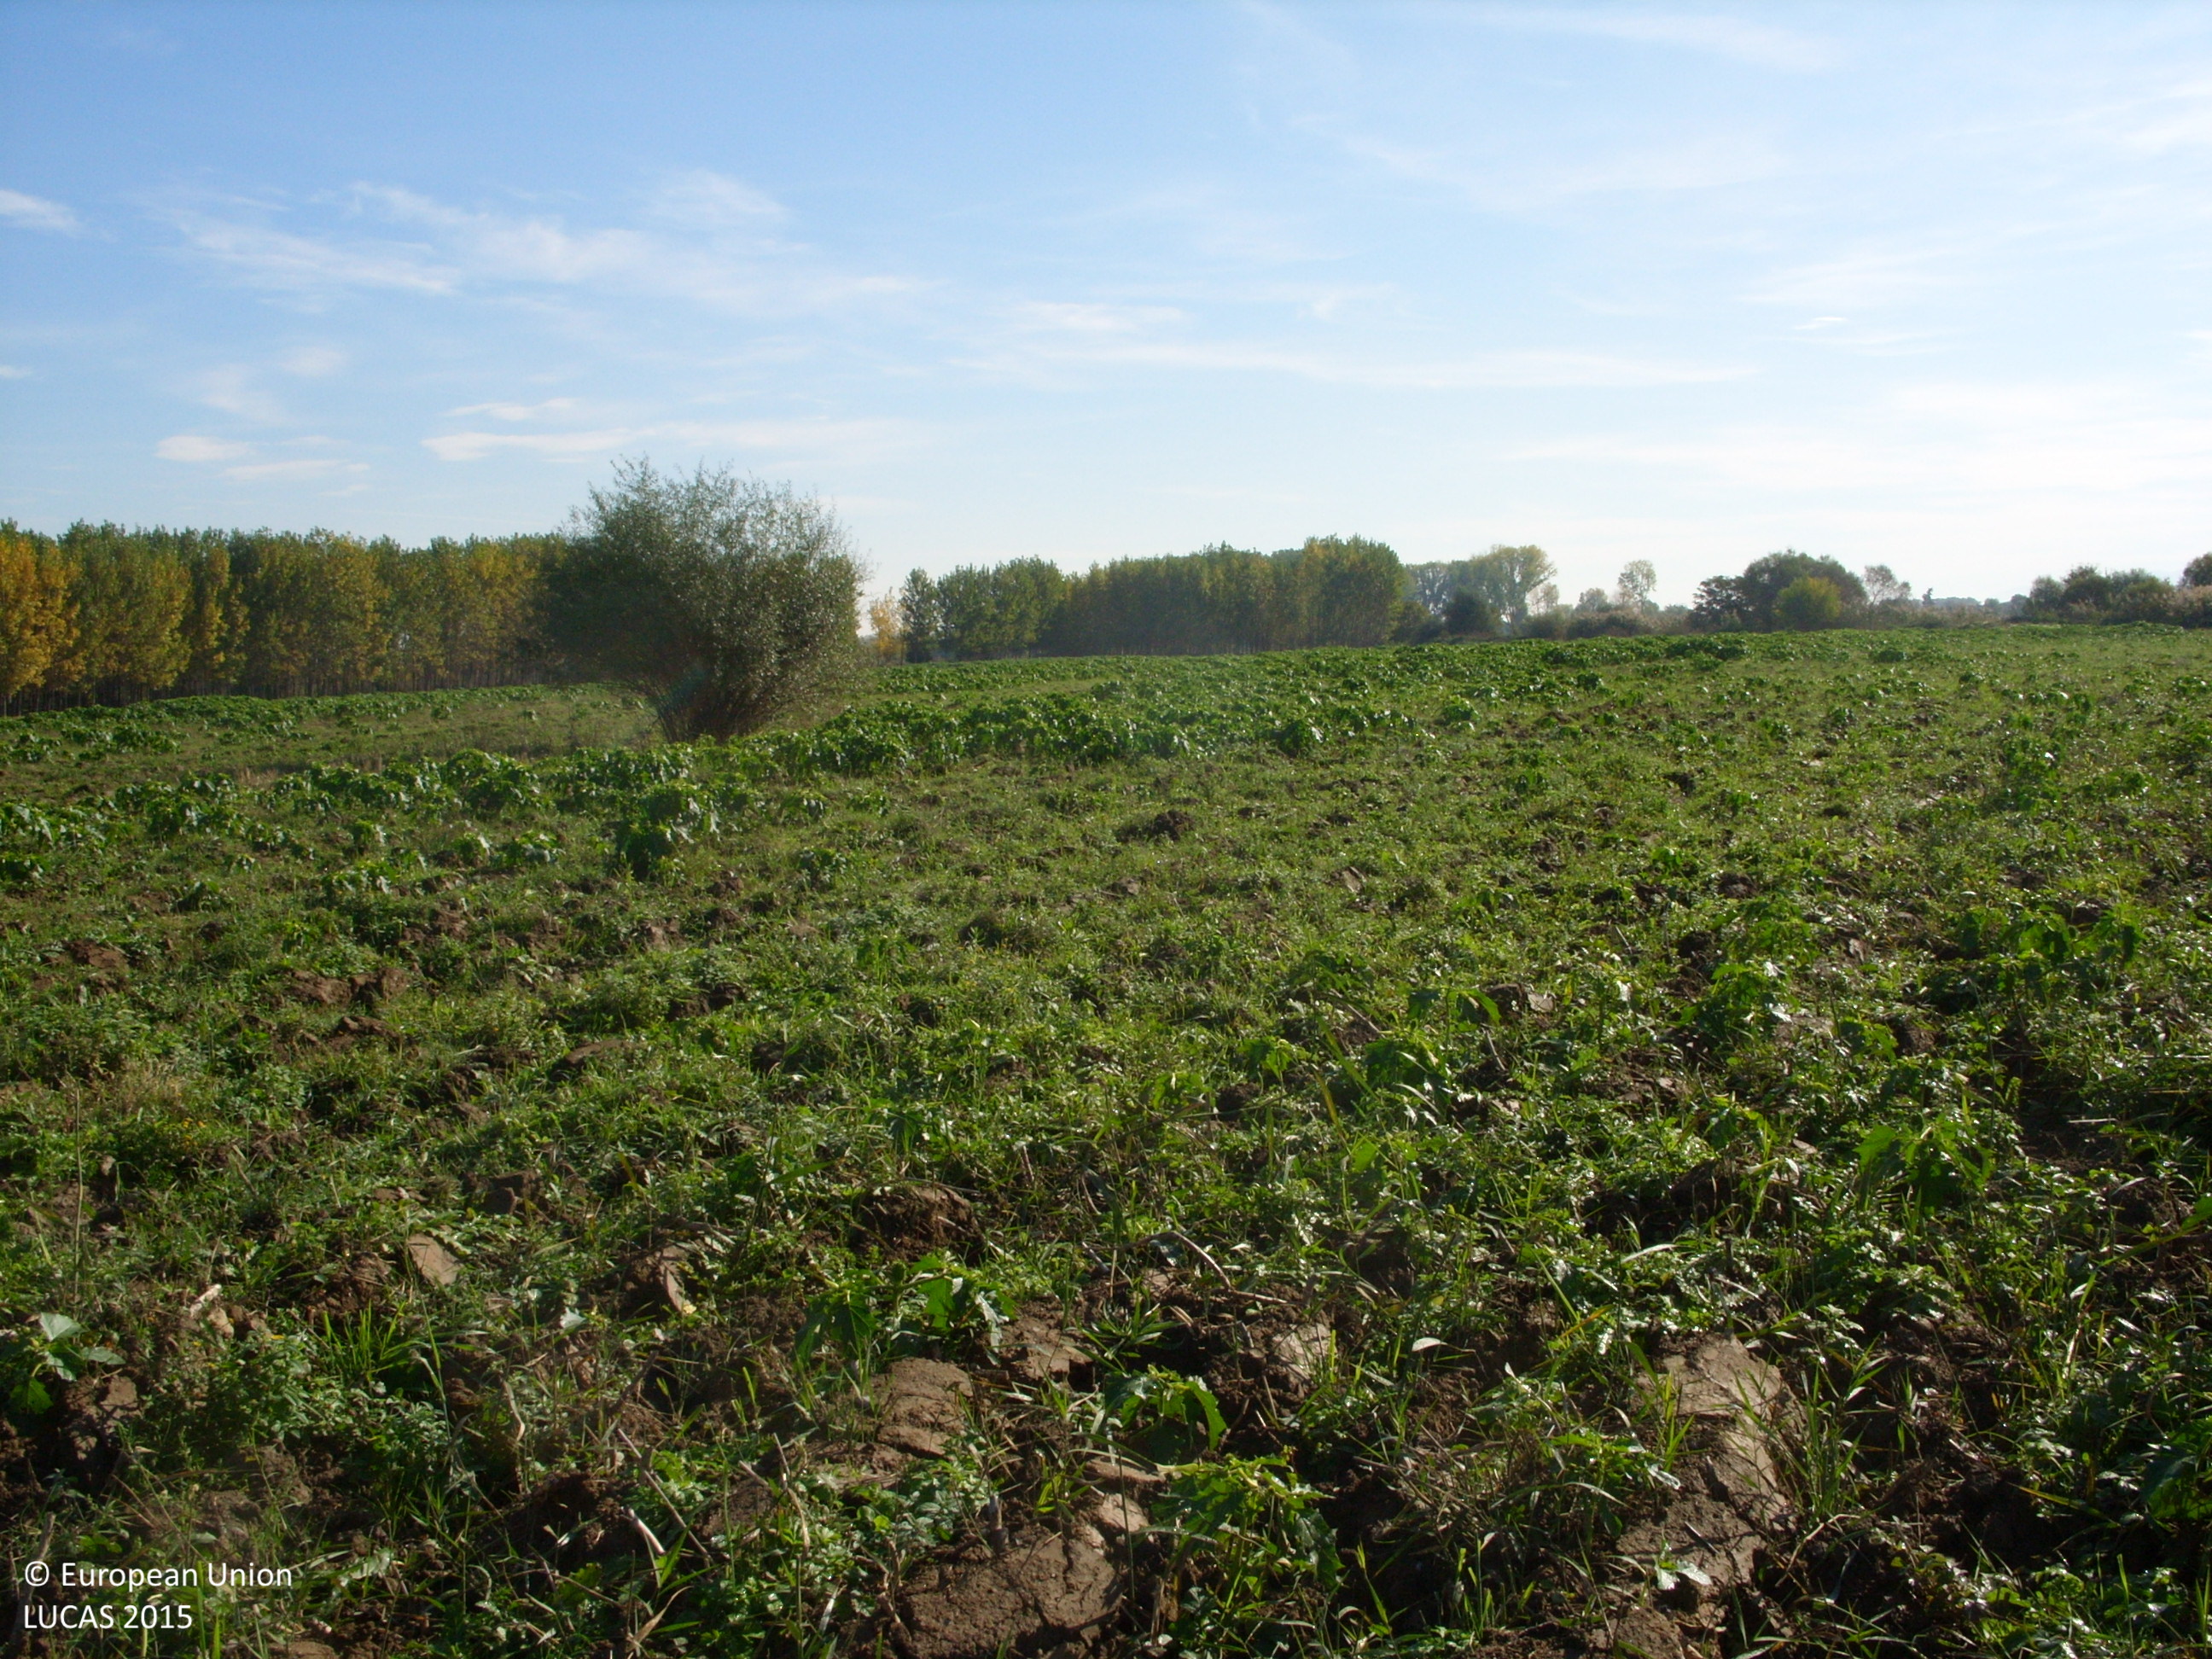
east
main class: Cropland
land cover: Barley
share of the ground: < 10 %
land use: Agriculture (excluding fallow land and kitchen gardens)
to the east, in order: Barley
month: October
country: BG
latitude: 42.2216
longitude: 24.1560
